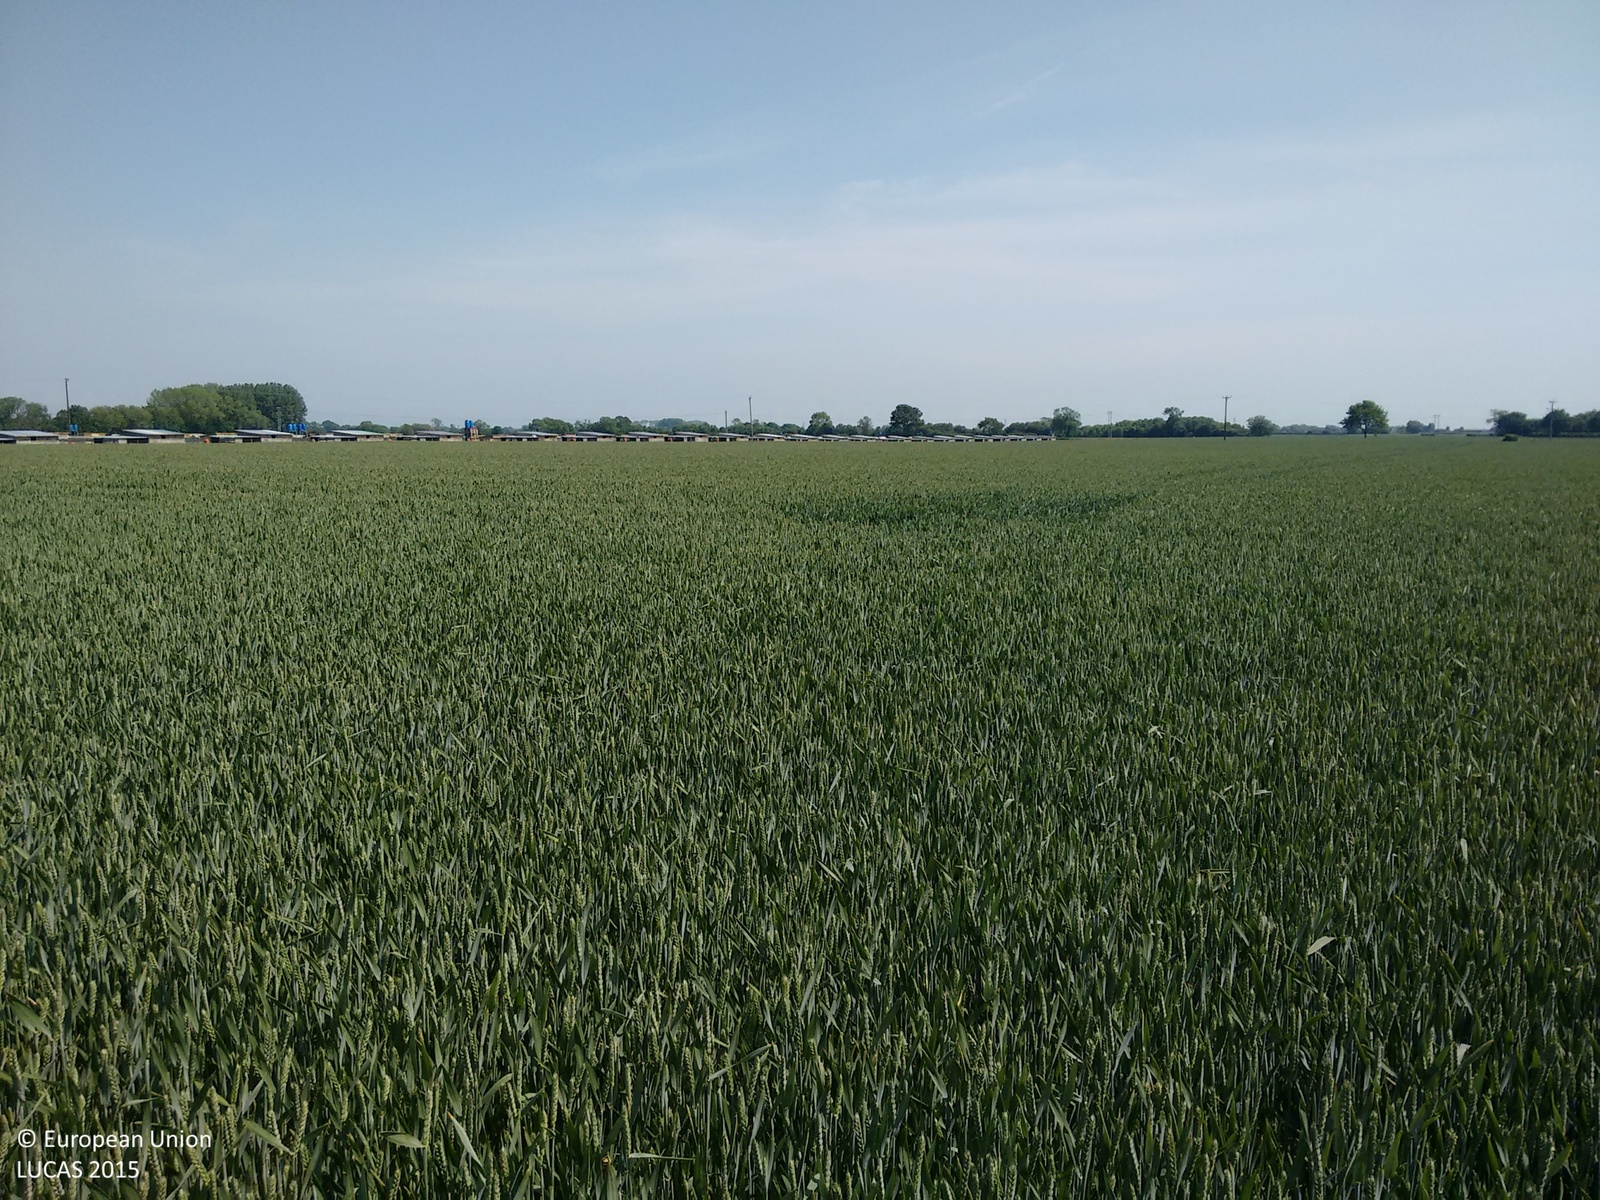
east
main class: Cropland
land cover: Common wheat
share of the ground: > 75 %
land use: Agriculture (excluding fallow land and kitchen gardens)
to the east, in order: Common wheat; Electric lines; Common wheat
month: June
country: GB
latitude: 53.8320
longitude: -1.1213
